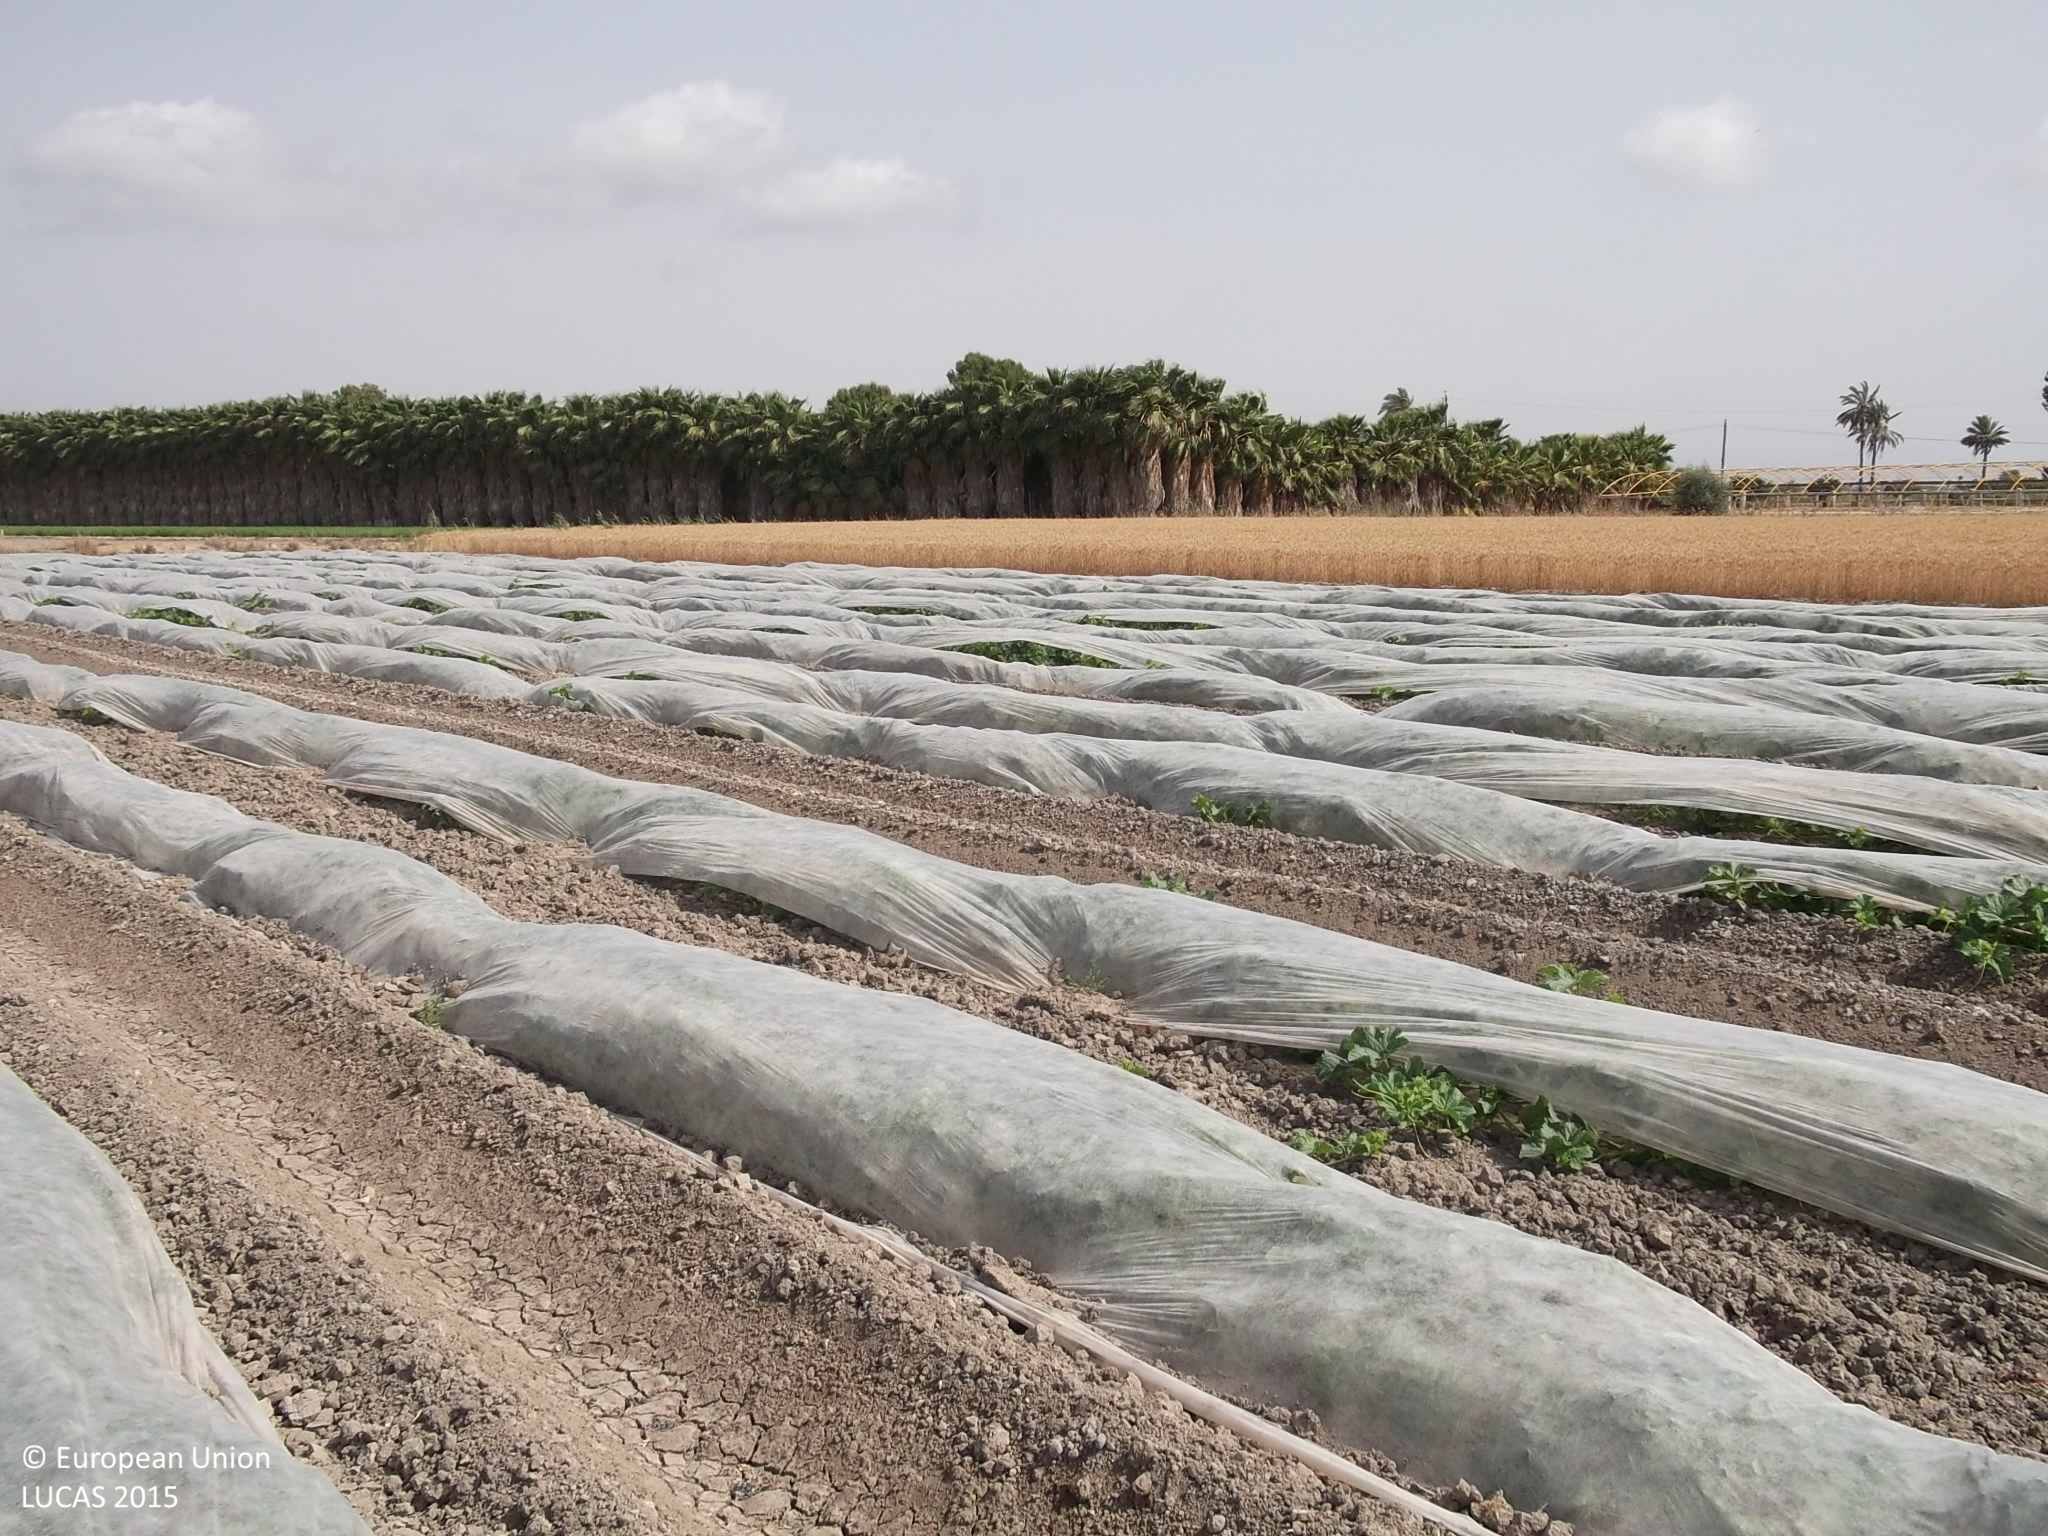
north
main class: Cropland
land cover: Other fresh vegetables
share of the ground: > 75 %
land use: Agriculture (excluding fallow land and kitchen gardens)
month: May
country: ES
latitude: 38.1268
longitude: -0.7184
